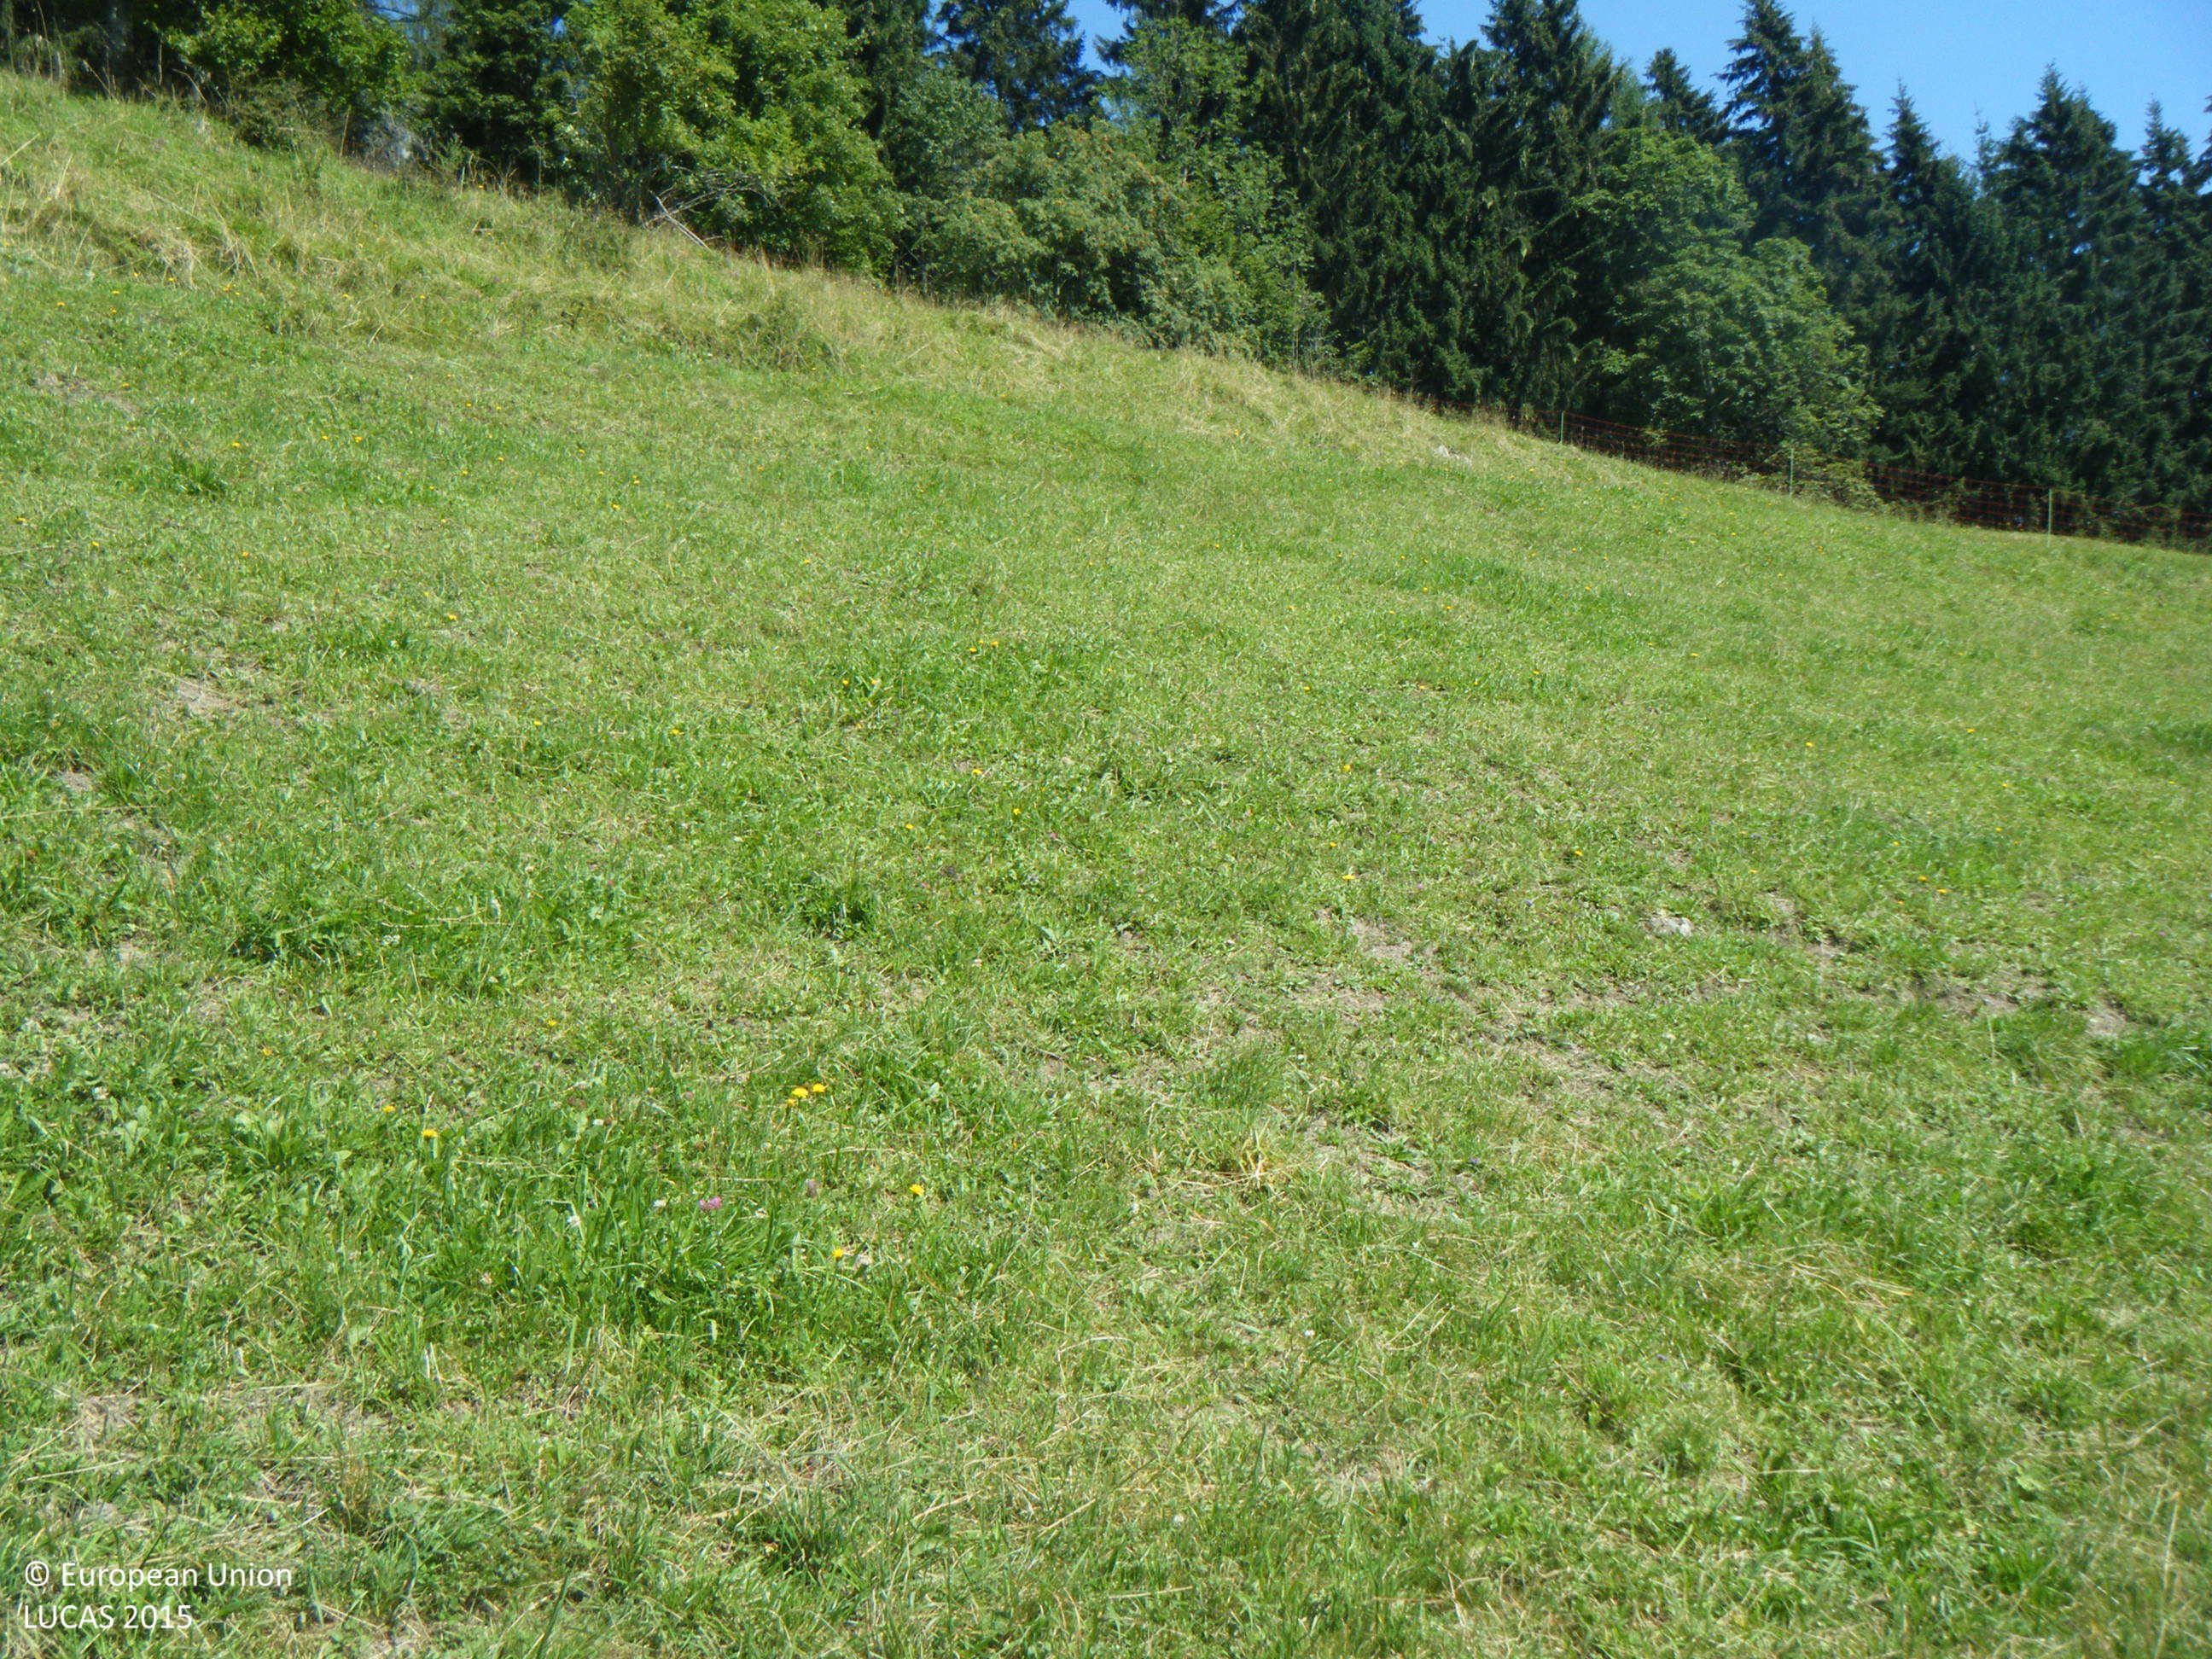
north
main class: Grassland
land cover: Grassland without tree/shrub cover
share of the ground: > 75 %
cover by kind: herbaceous plants 100 %
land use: Agriculture (excluding fallow land and kitchen gardens)
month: August
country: AT
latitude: 47.5564
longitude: 13.9989
